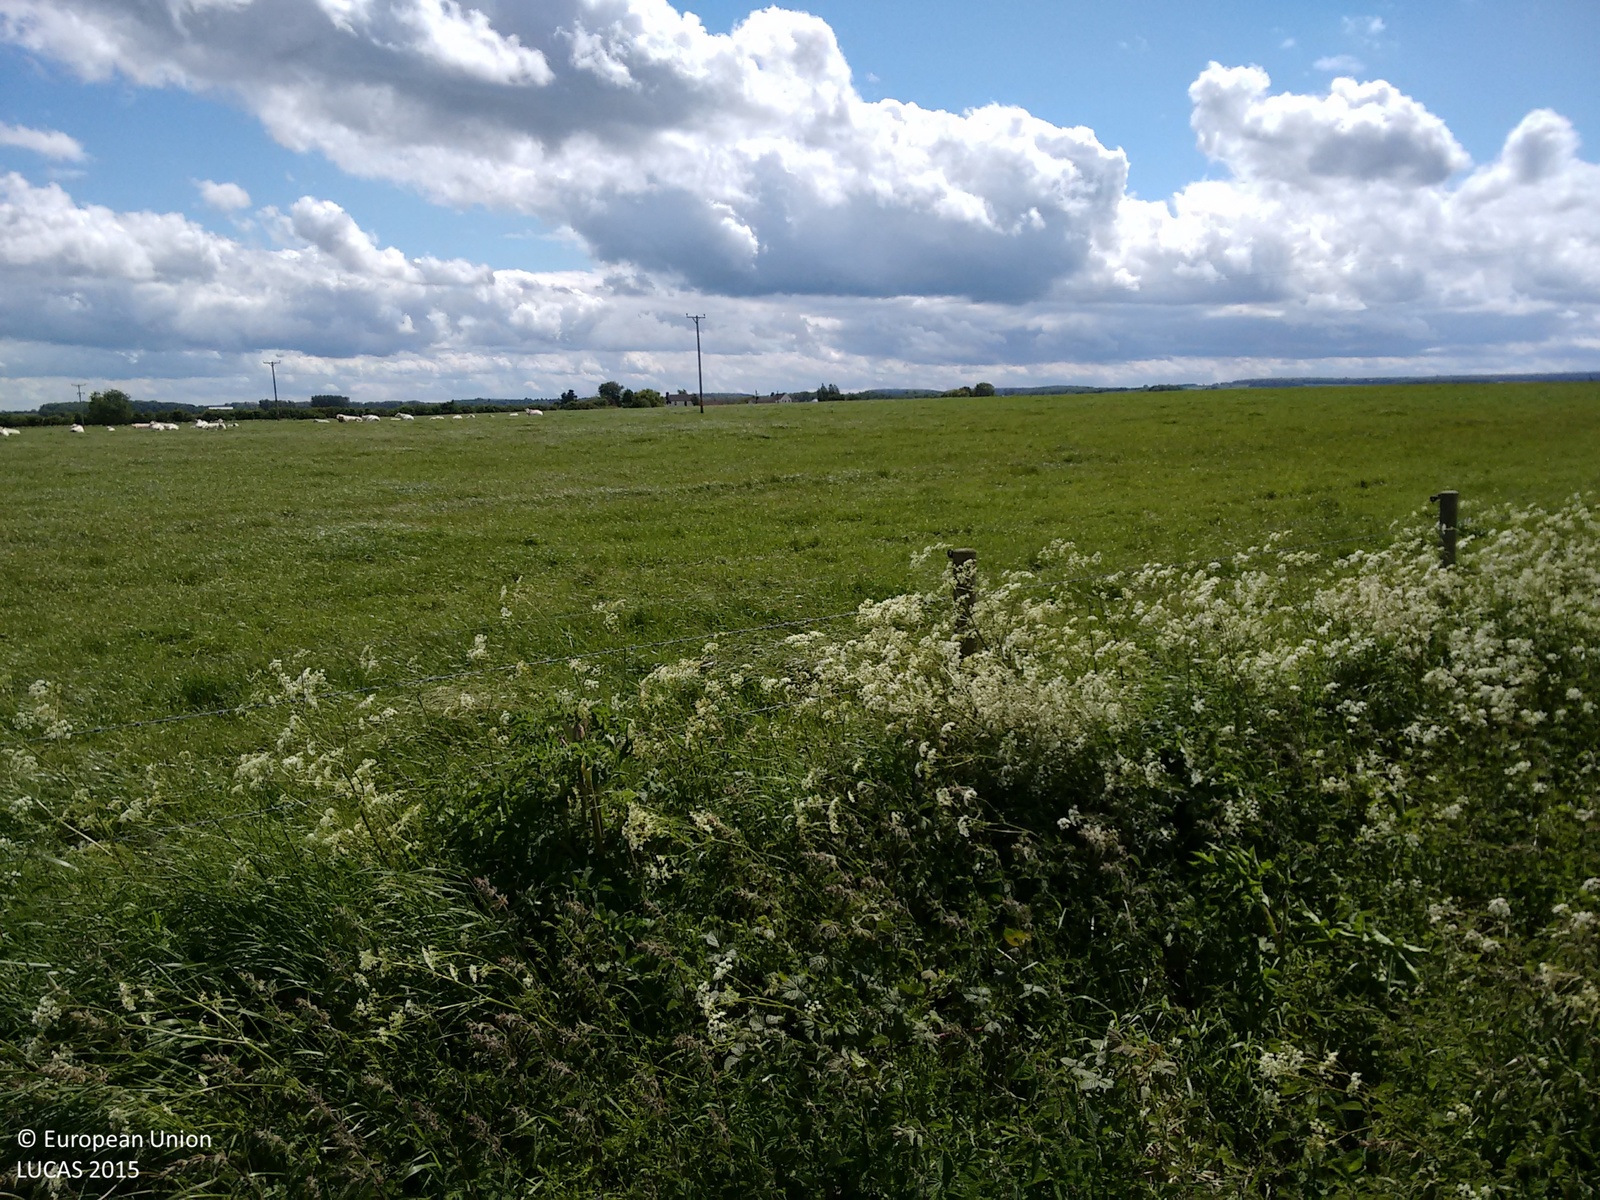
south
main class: Grassland
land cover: Grassland without tree/shrub cover
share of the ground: > 75 %
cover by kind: herbaceous plants 100 %
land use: Agriculture (excluding fallow land and kitchen gardens)
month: June
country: GB
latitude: 53.5839
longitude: -0.2302
